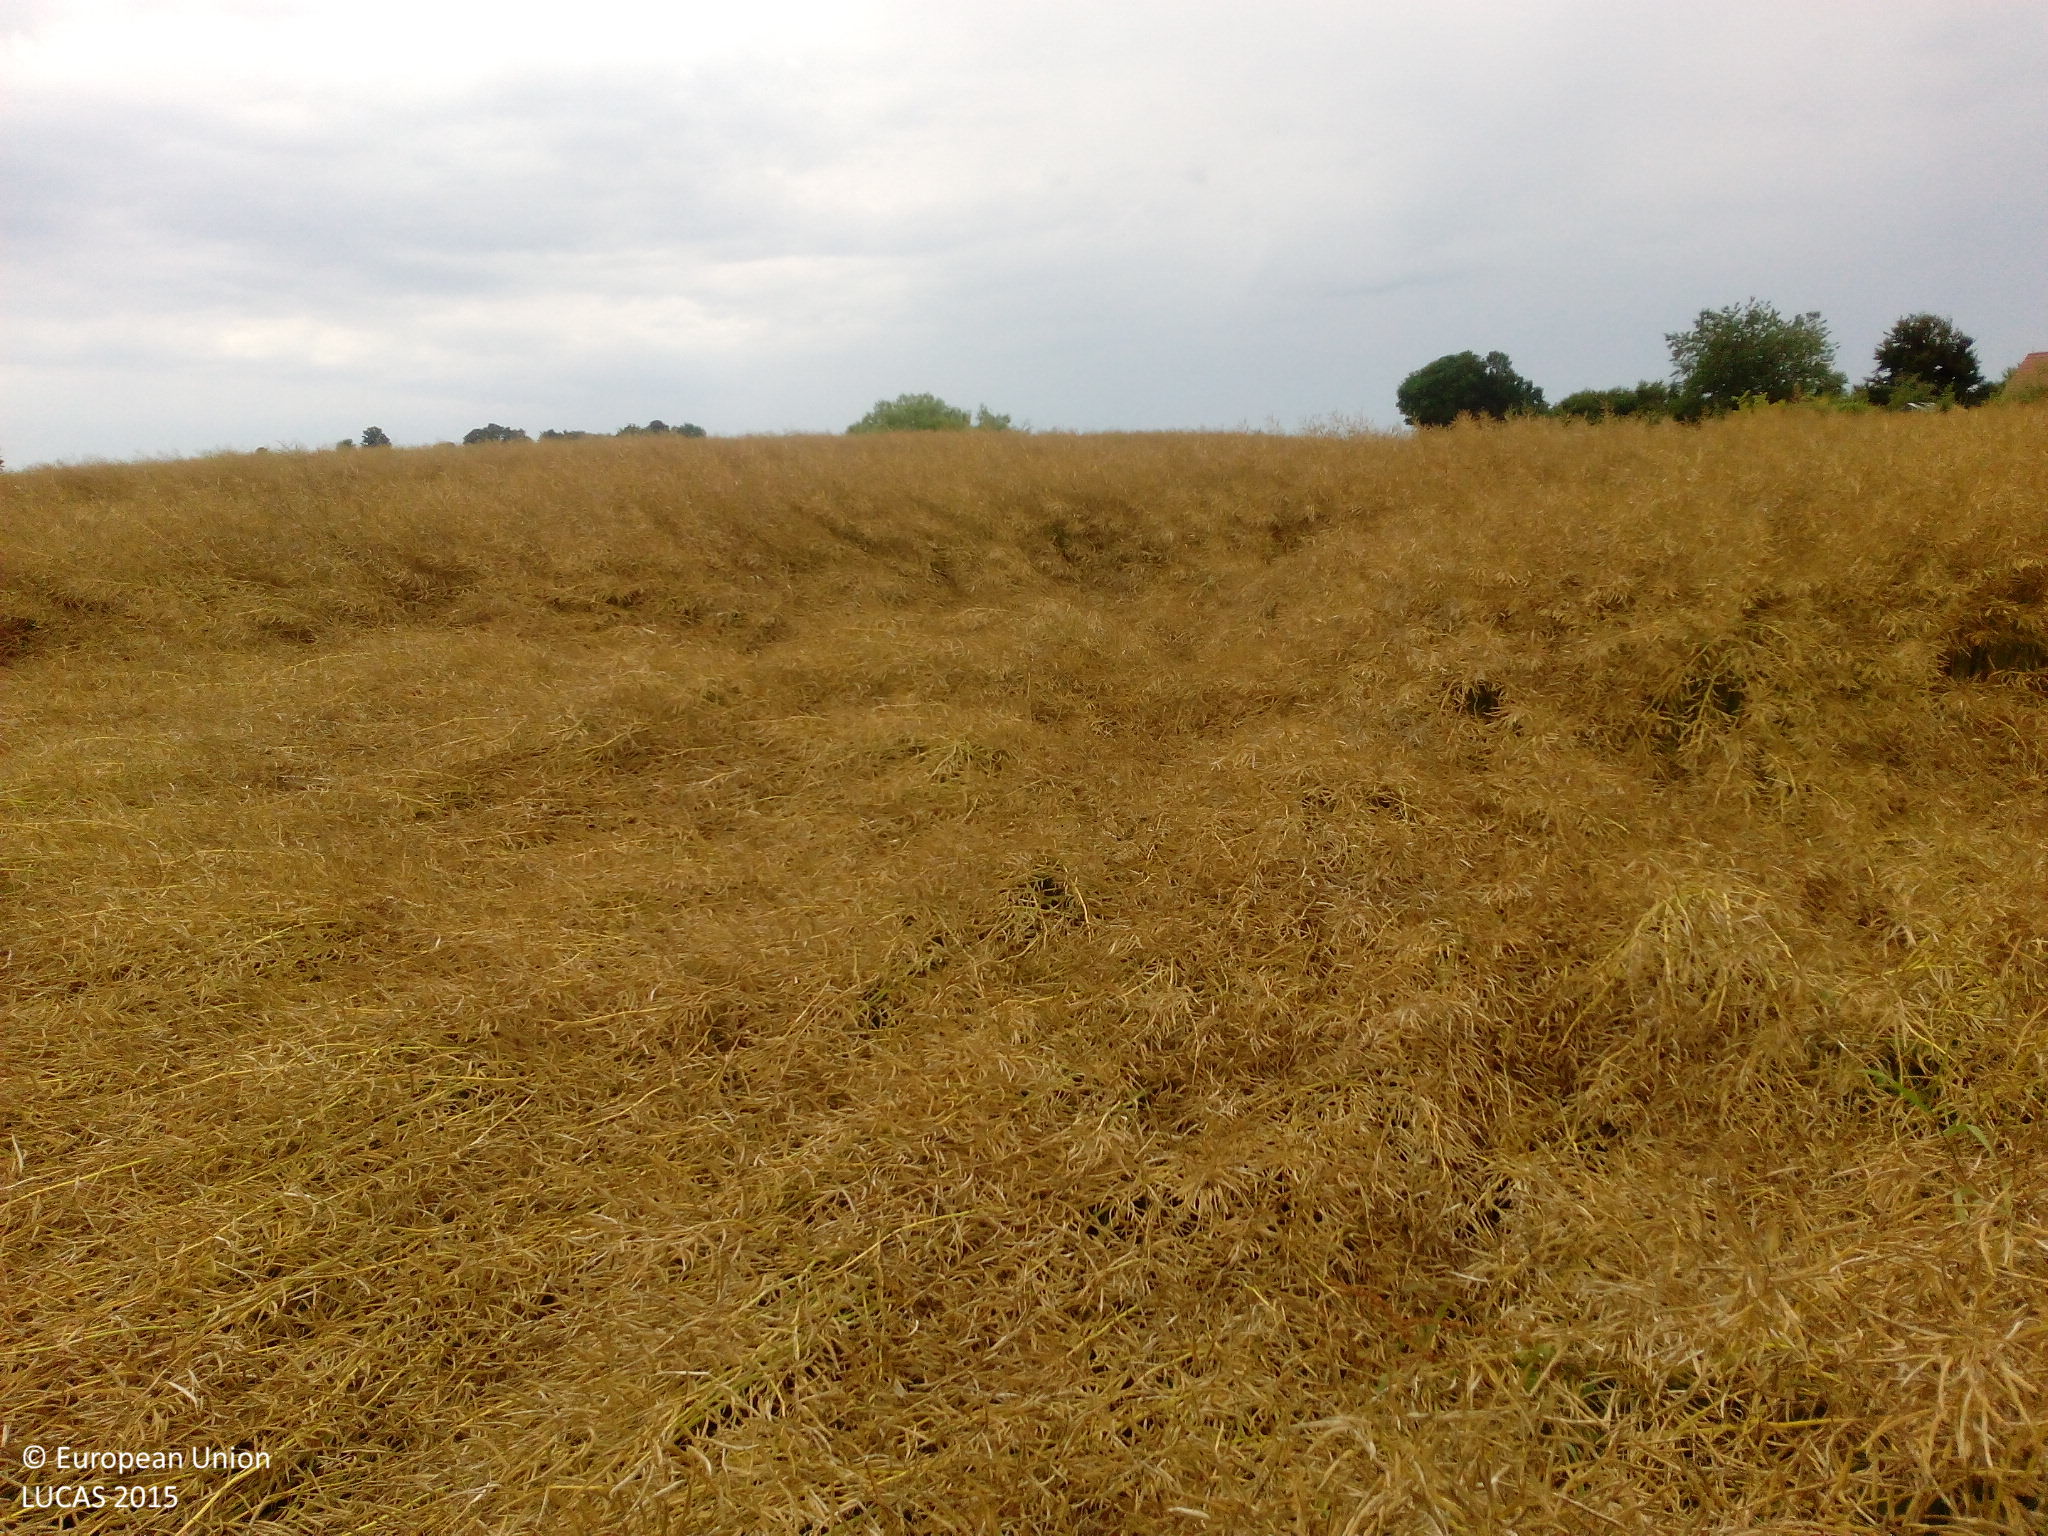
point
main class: Cropland
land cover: Rape and turnip rape
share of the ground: > 75 %
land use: Agriculture (excluding fallow land and kitchen gardens)
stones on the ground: < 10 %
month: August
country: DK
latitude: 55.5267
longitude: 11.8835
